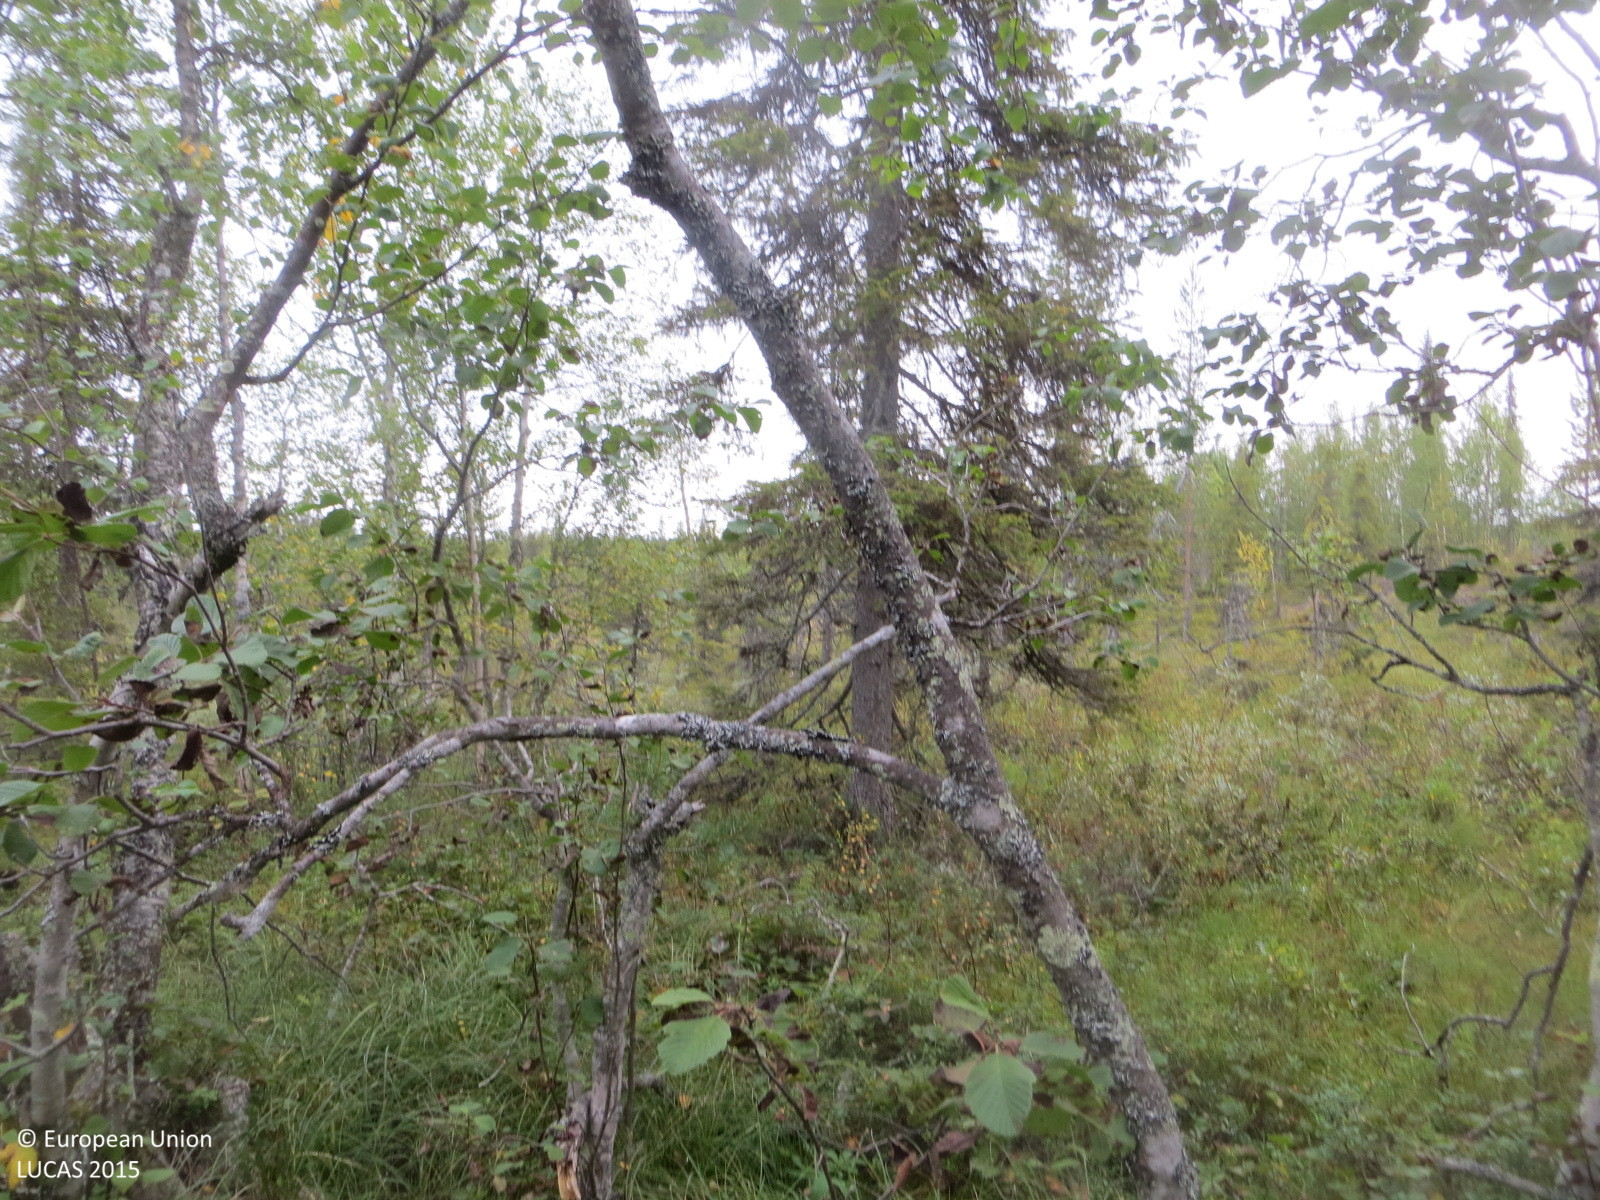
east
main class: Woodland
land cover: Spruce dominated mixed woodland
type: mire and swamp forests
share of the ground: 50 - 75 %
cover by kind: coniferous forest trees 35 %, broadleaved forest trees 35 %, herbaceous plants 20 %, shrubs 10 %
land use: Forestry
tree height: > 5 m
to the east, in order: Spruce dominated mixed woodland; Pine dominated coniferous woodland; Spruce dominated mixed woodland; Inland fresh running water; Spruce dominated mixed woodland; Inland fresh running water; Spruce dominated mixed woodland
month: August
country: FI
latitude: 67.4978
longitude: 24.2390
